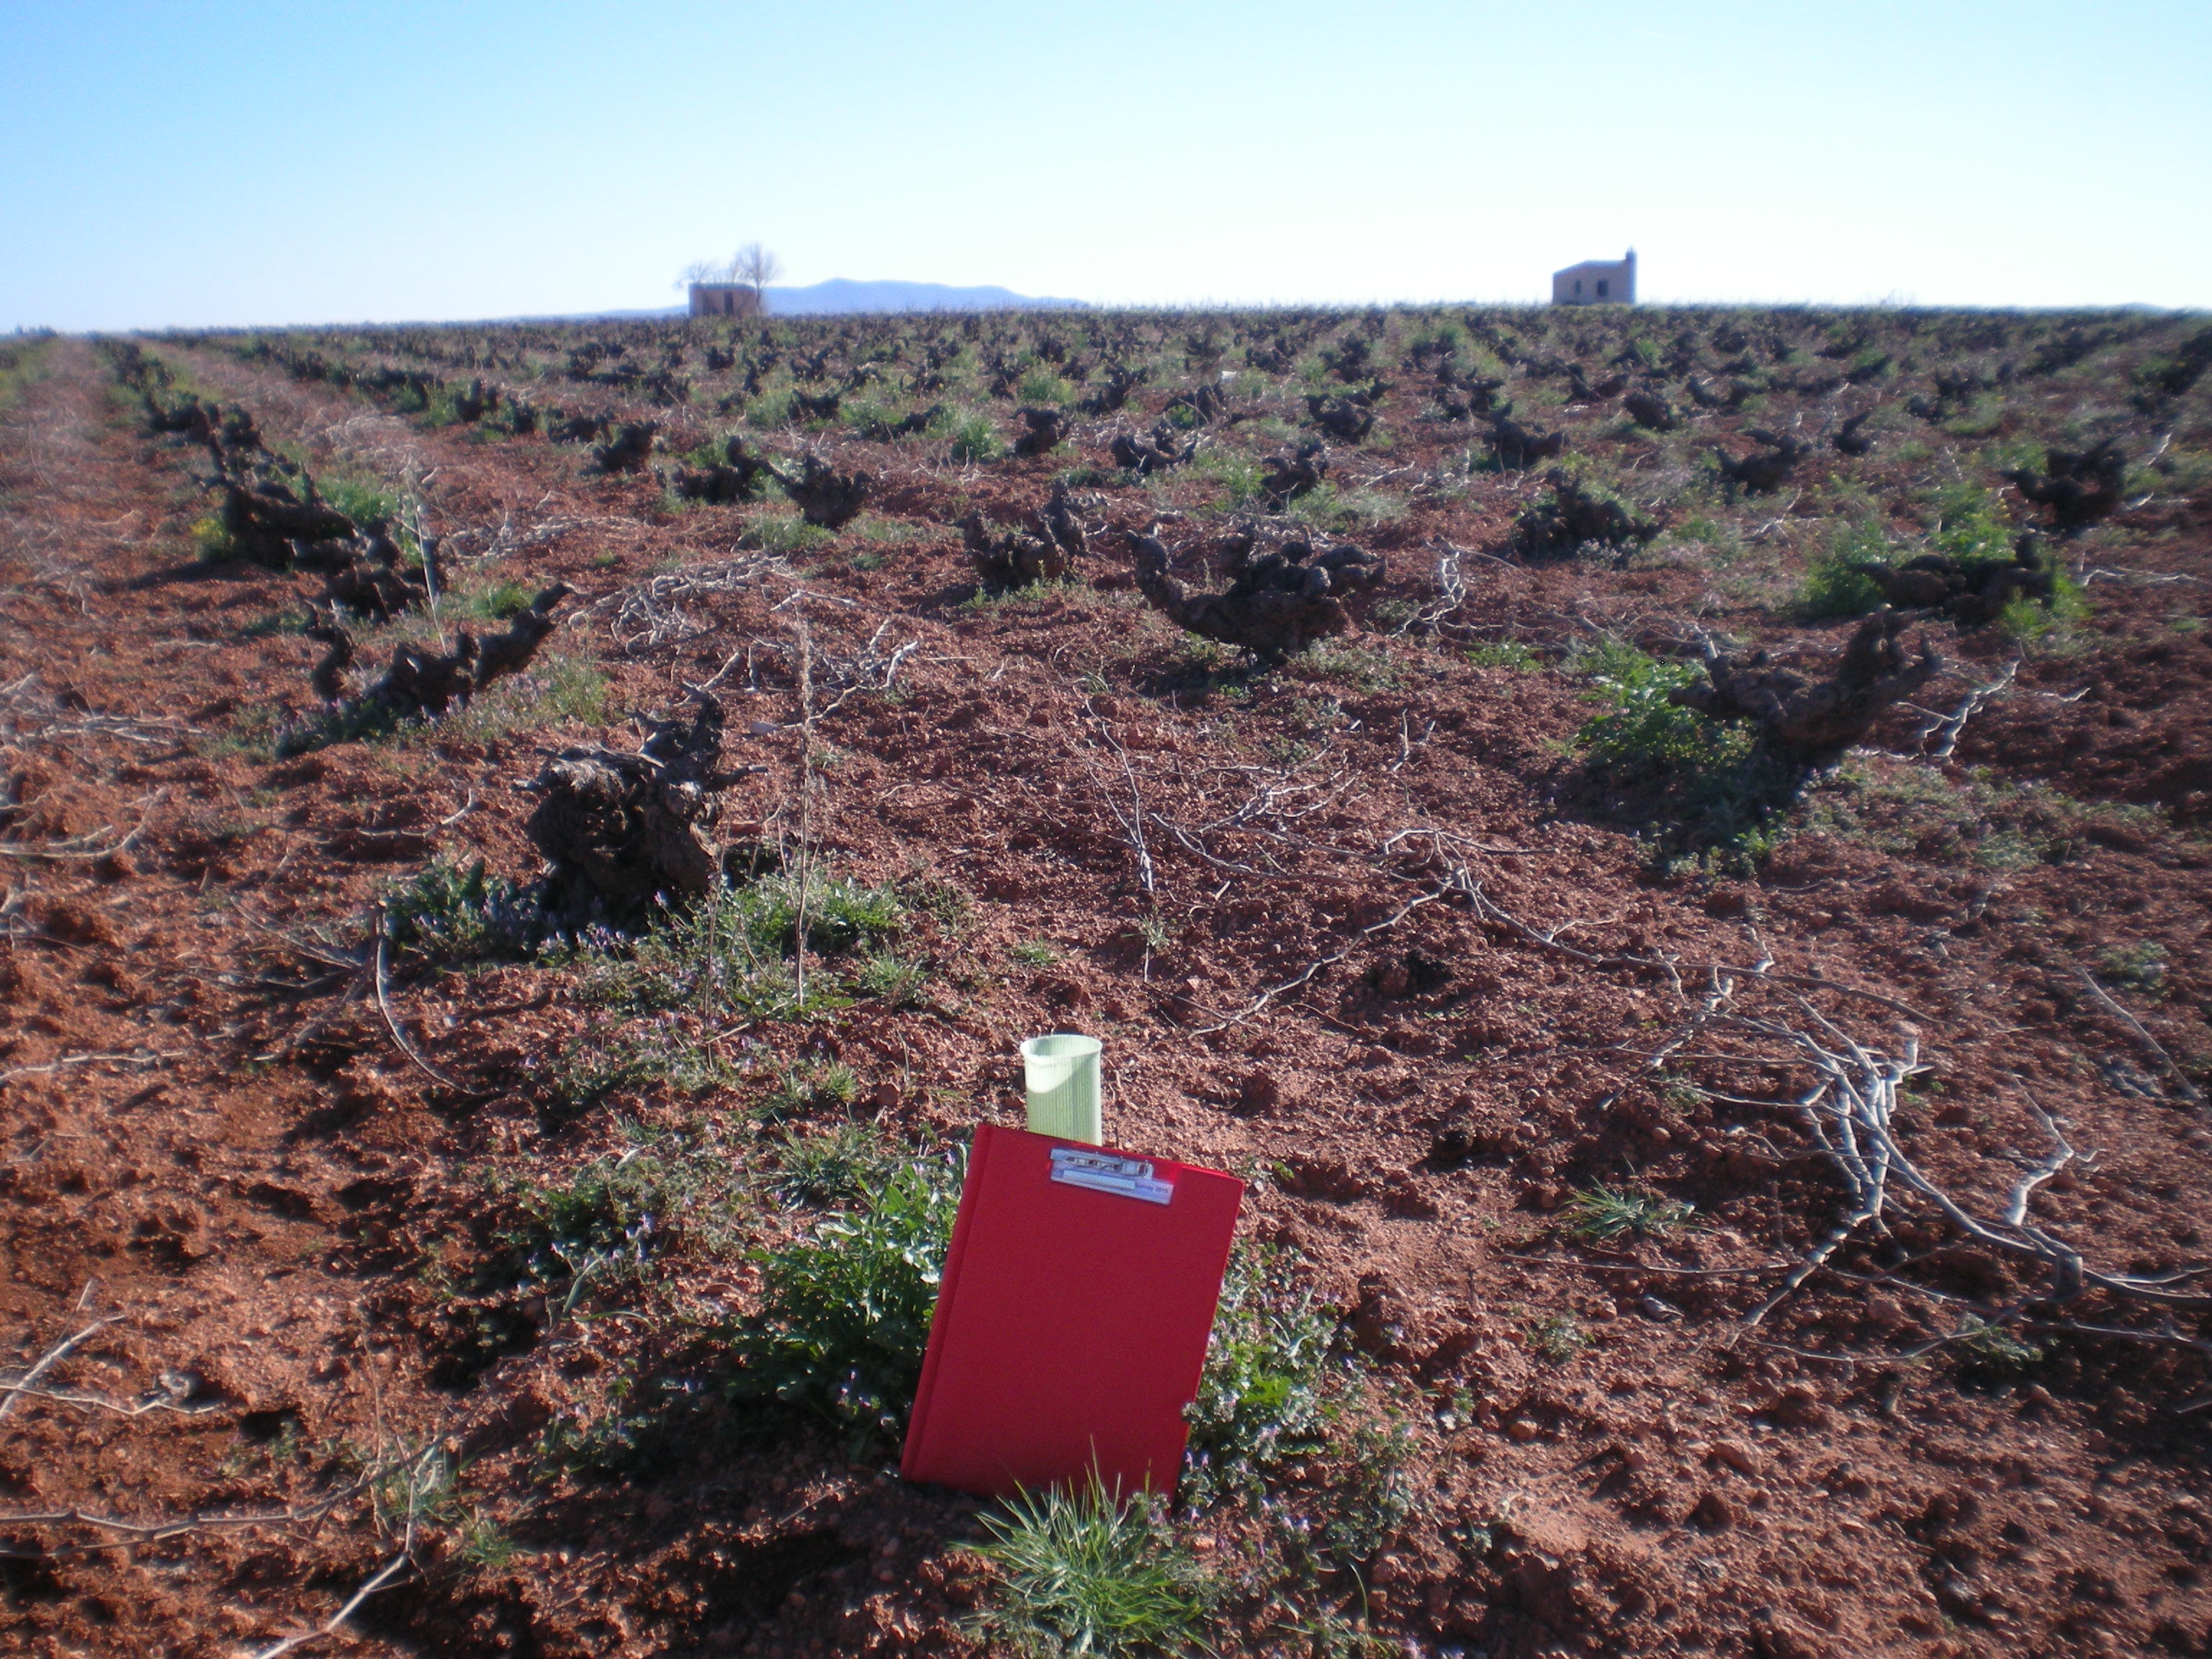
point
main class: Cropland
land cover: Vineyards
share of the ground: < 10 %
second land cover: Other bare soil
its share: > 75 %
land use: Agriculture (excluding fallow land and kitchen gardens)
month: April
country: ES
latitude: 38.7747
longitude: -3.1419
